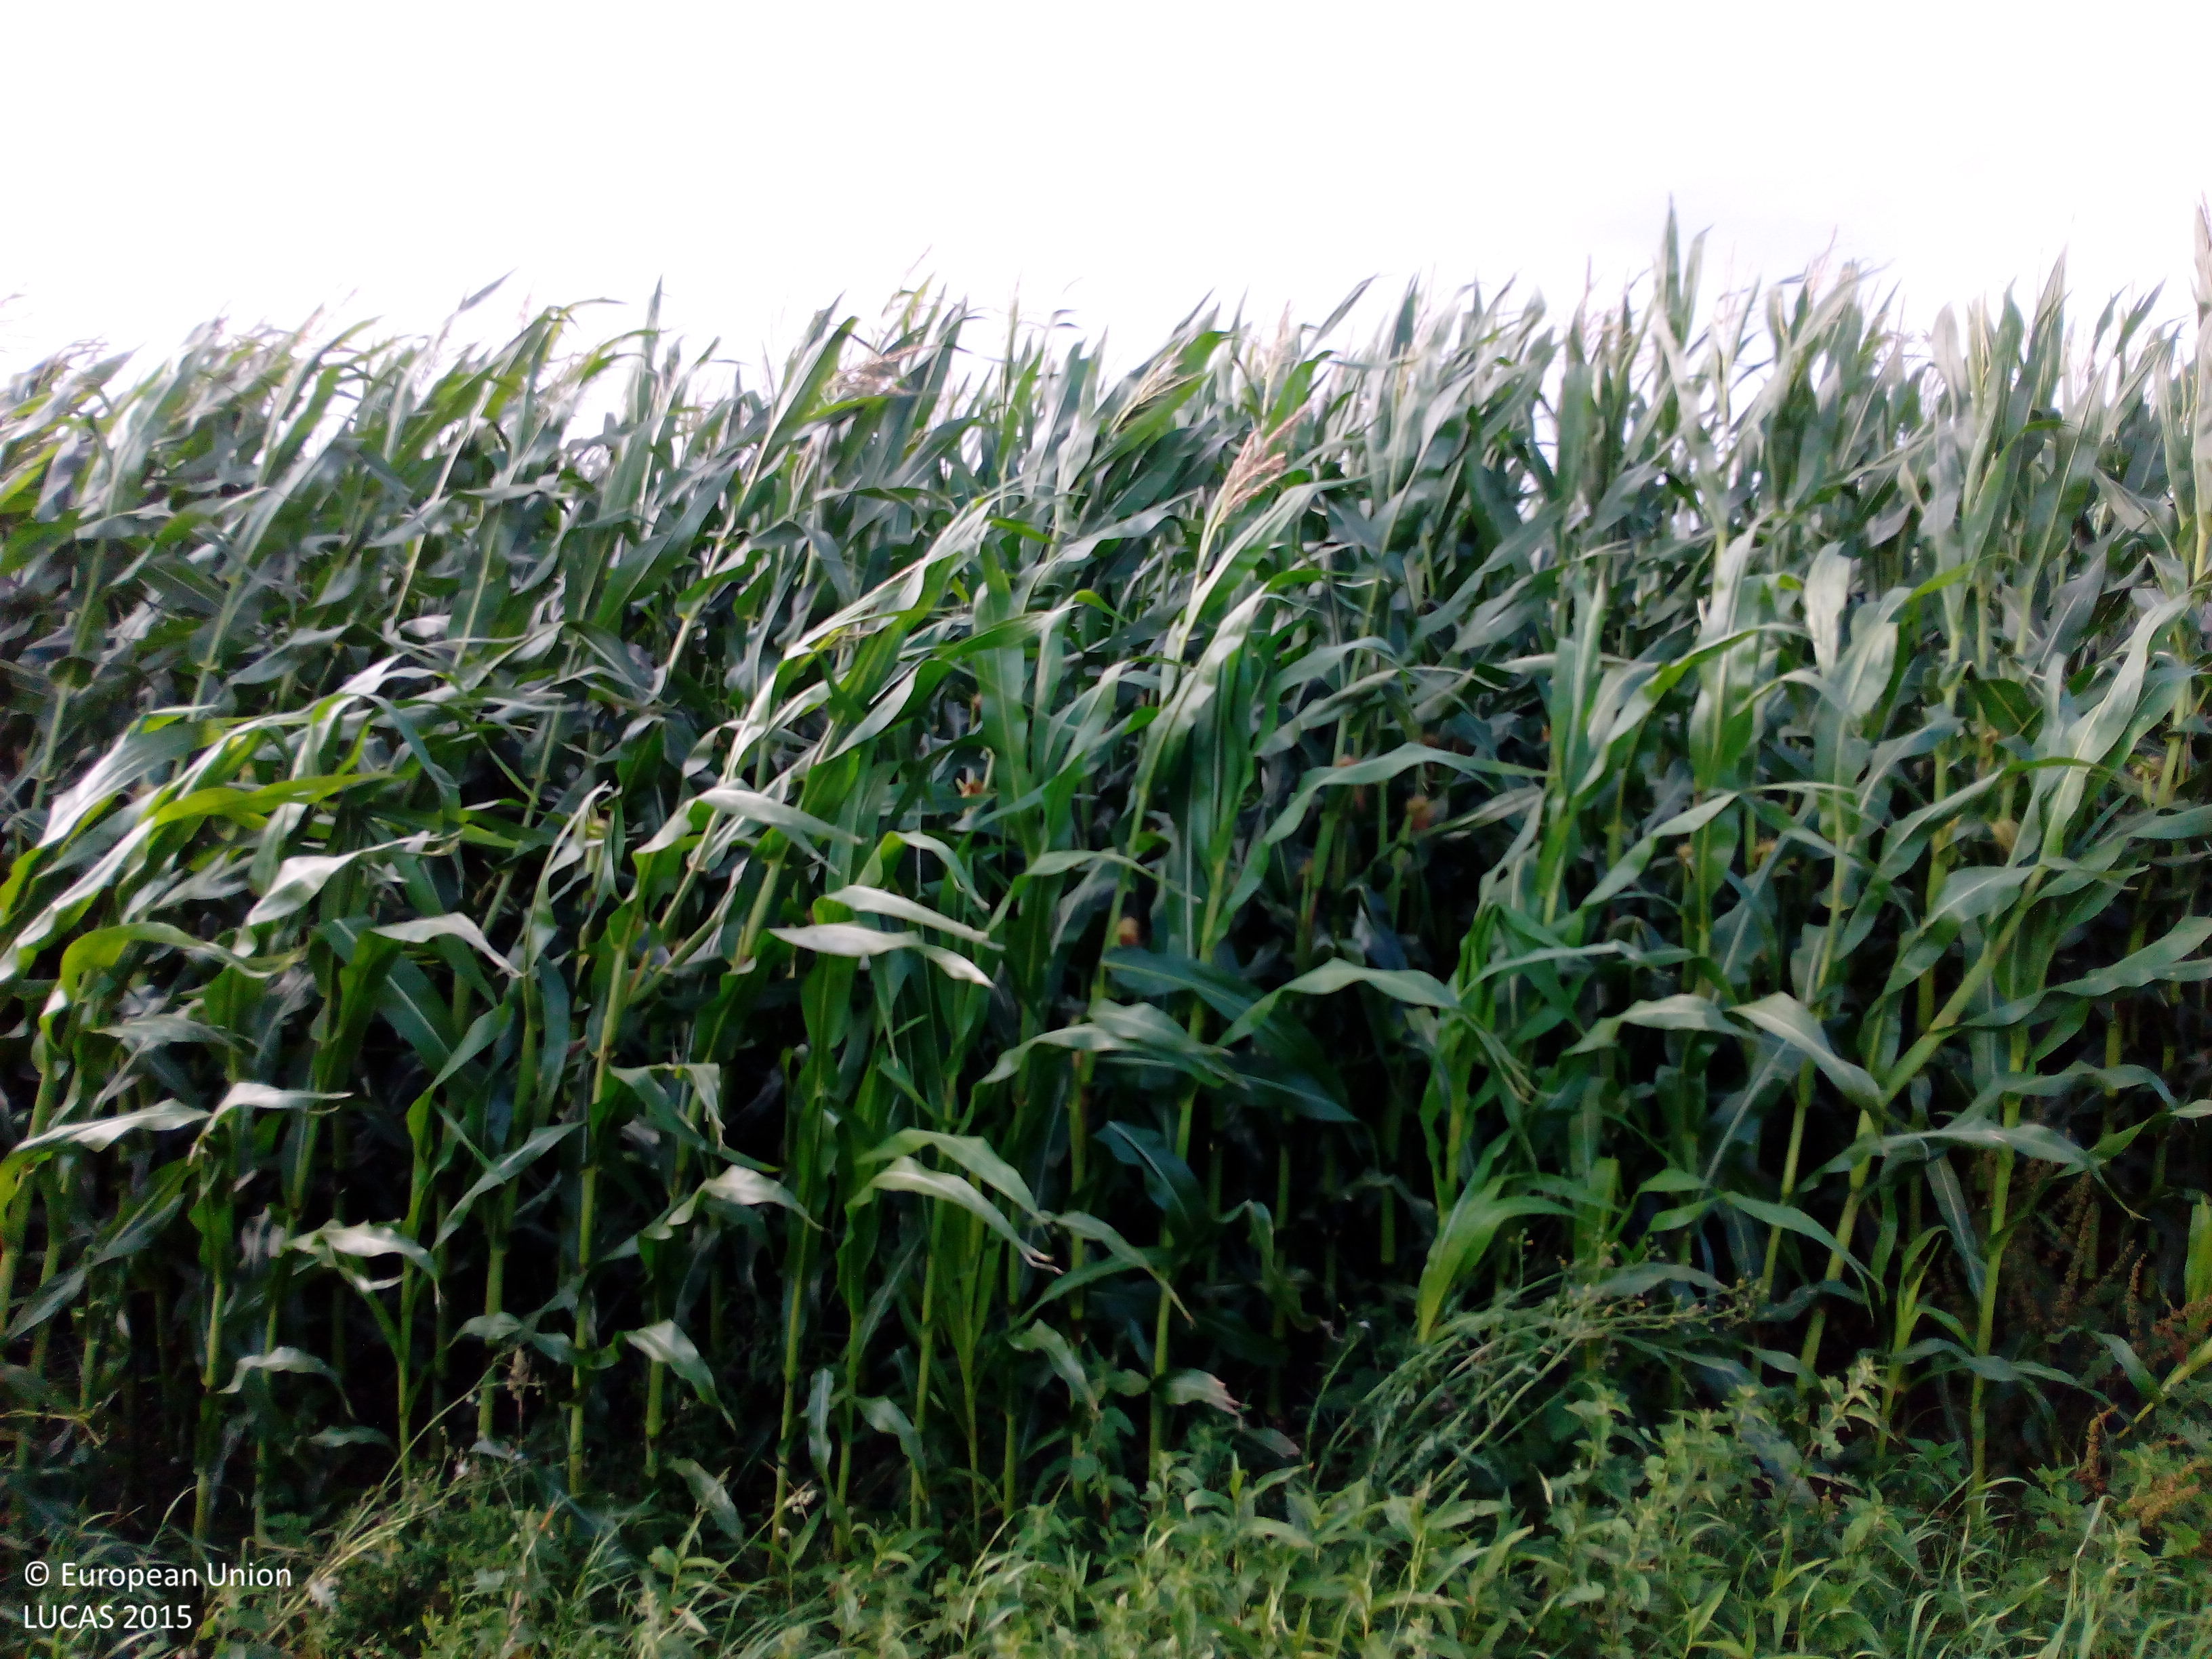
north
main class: Cropland
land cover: Maize
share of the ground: > 75 %
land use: Agriculture (excluding fallow land and kitchen gardens)
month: July
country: DE
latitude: 52.2421
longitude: 8.4920
